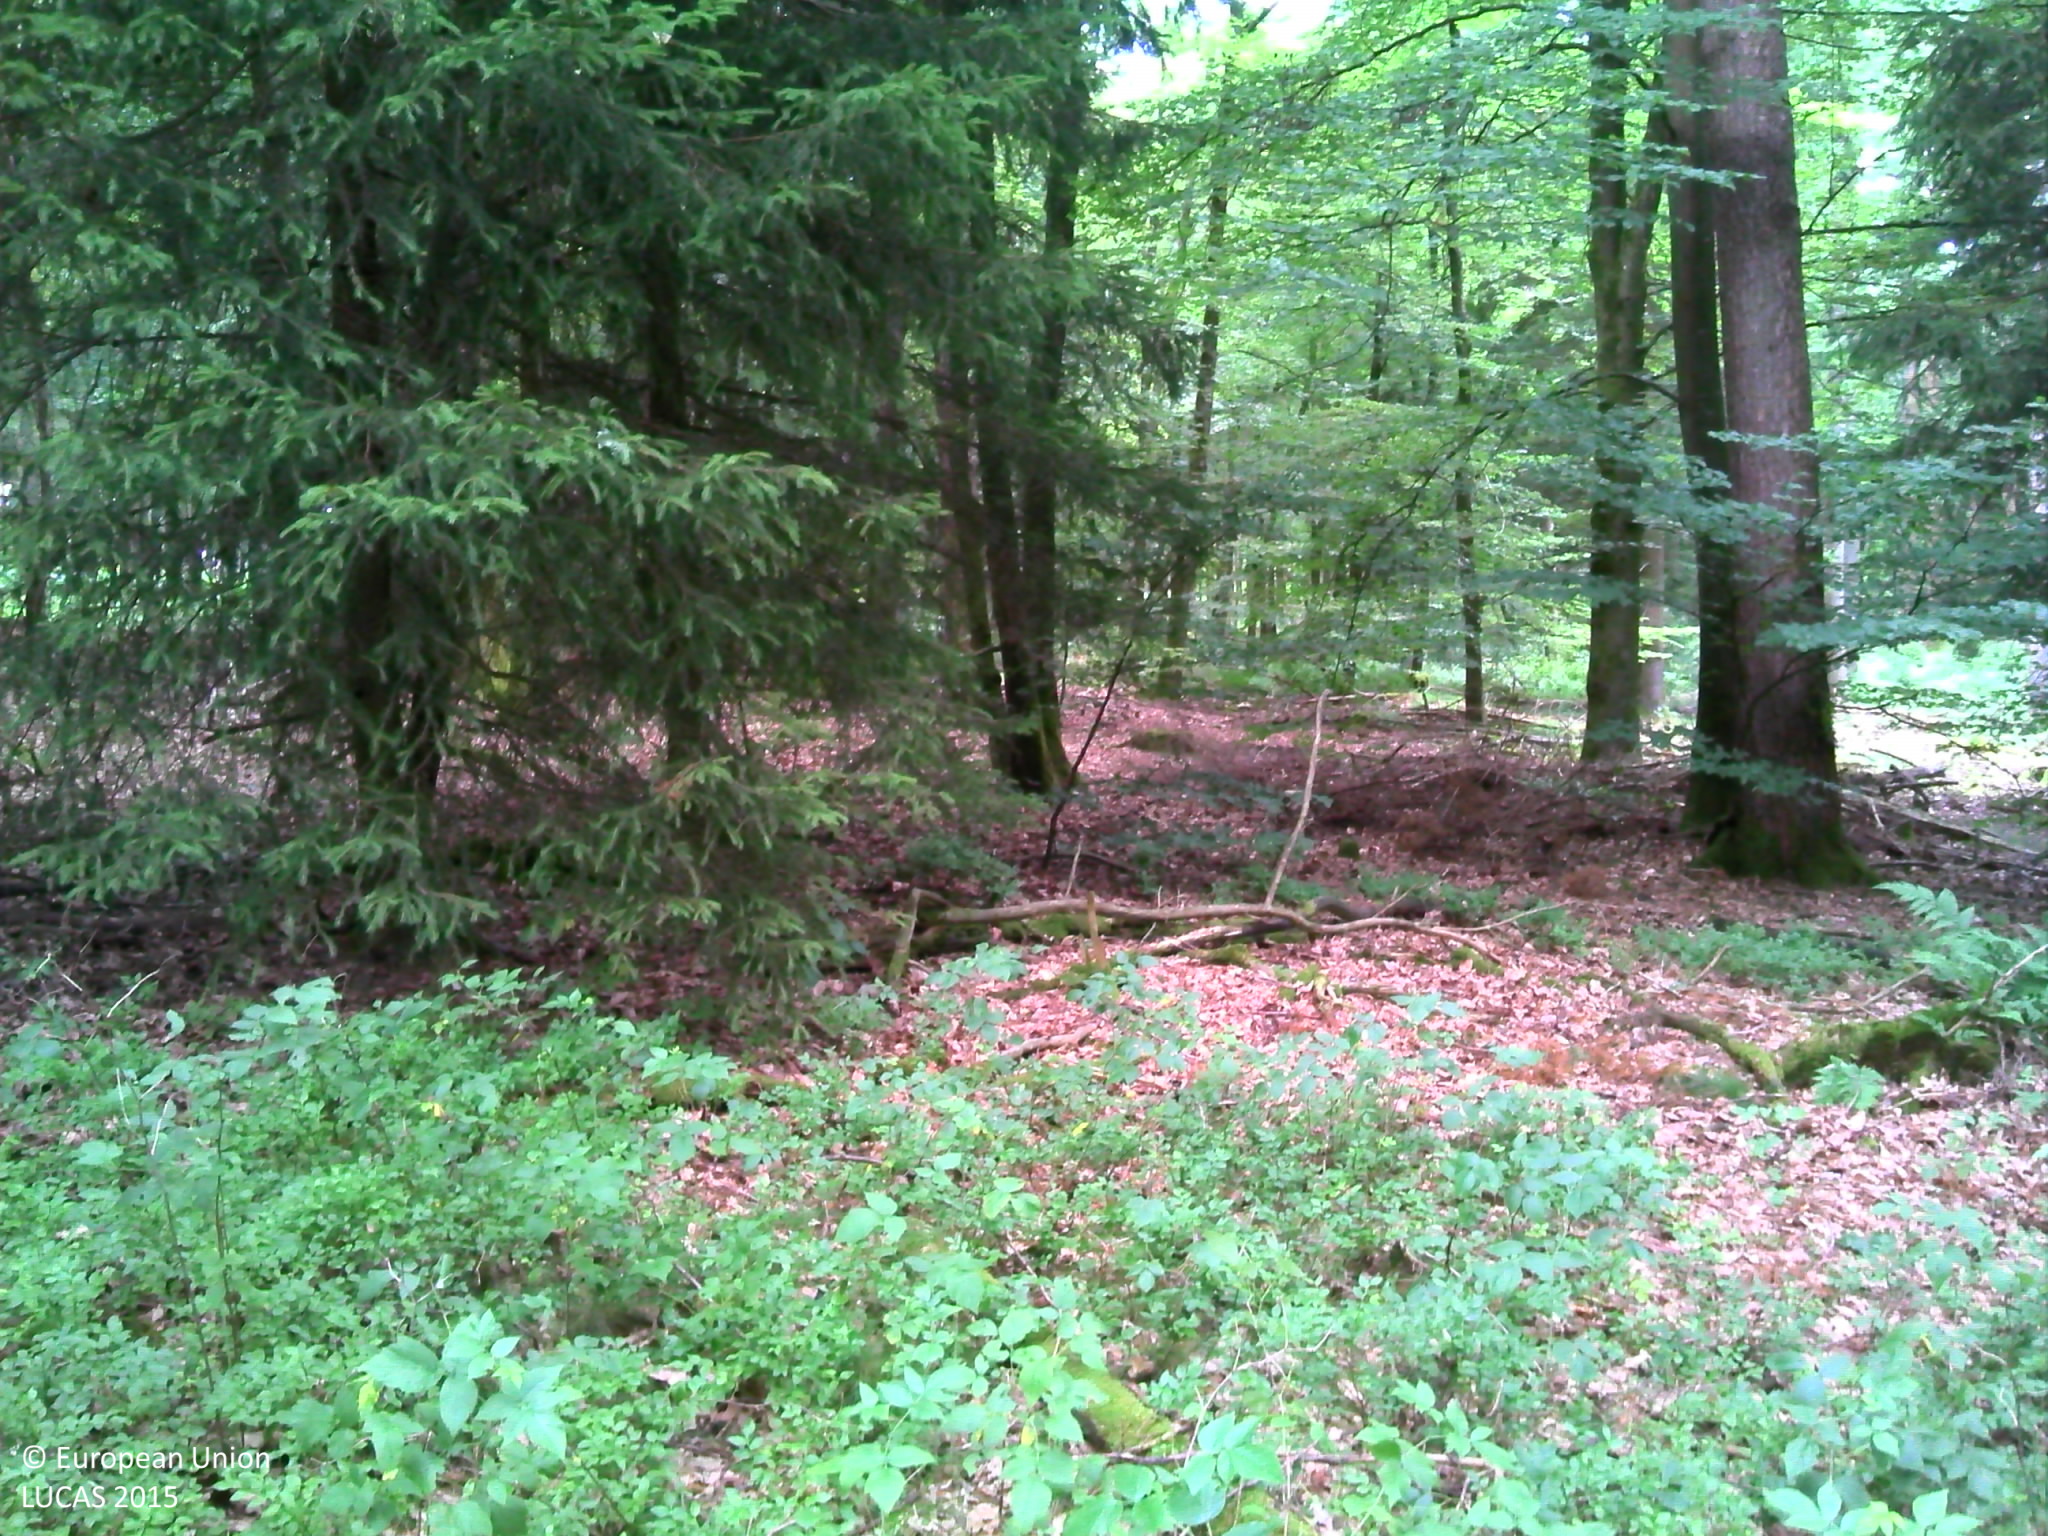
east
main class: Woodland
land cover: Broadleaved woodland
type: acidophilous oak and oak-birch forest
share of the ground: > 75 %
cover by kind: broadleaved forest trees 70 %, herbaceous plants 20 %, coniferous forest trees 10 %
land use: Forestry
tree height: > 5 m
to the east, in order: Broadleaved woodland; Tracks; Broadleaved woodland; Tracks; Other coniferous woodland; Broadleaved woodland; Spontaneously vegetated surfaces; Tracks; Other coniferous woodland
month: July
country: BE
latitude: 49.6336
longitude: 5.6650
